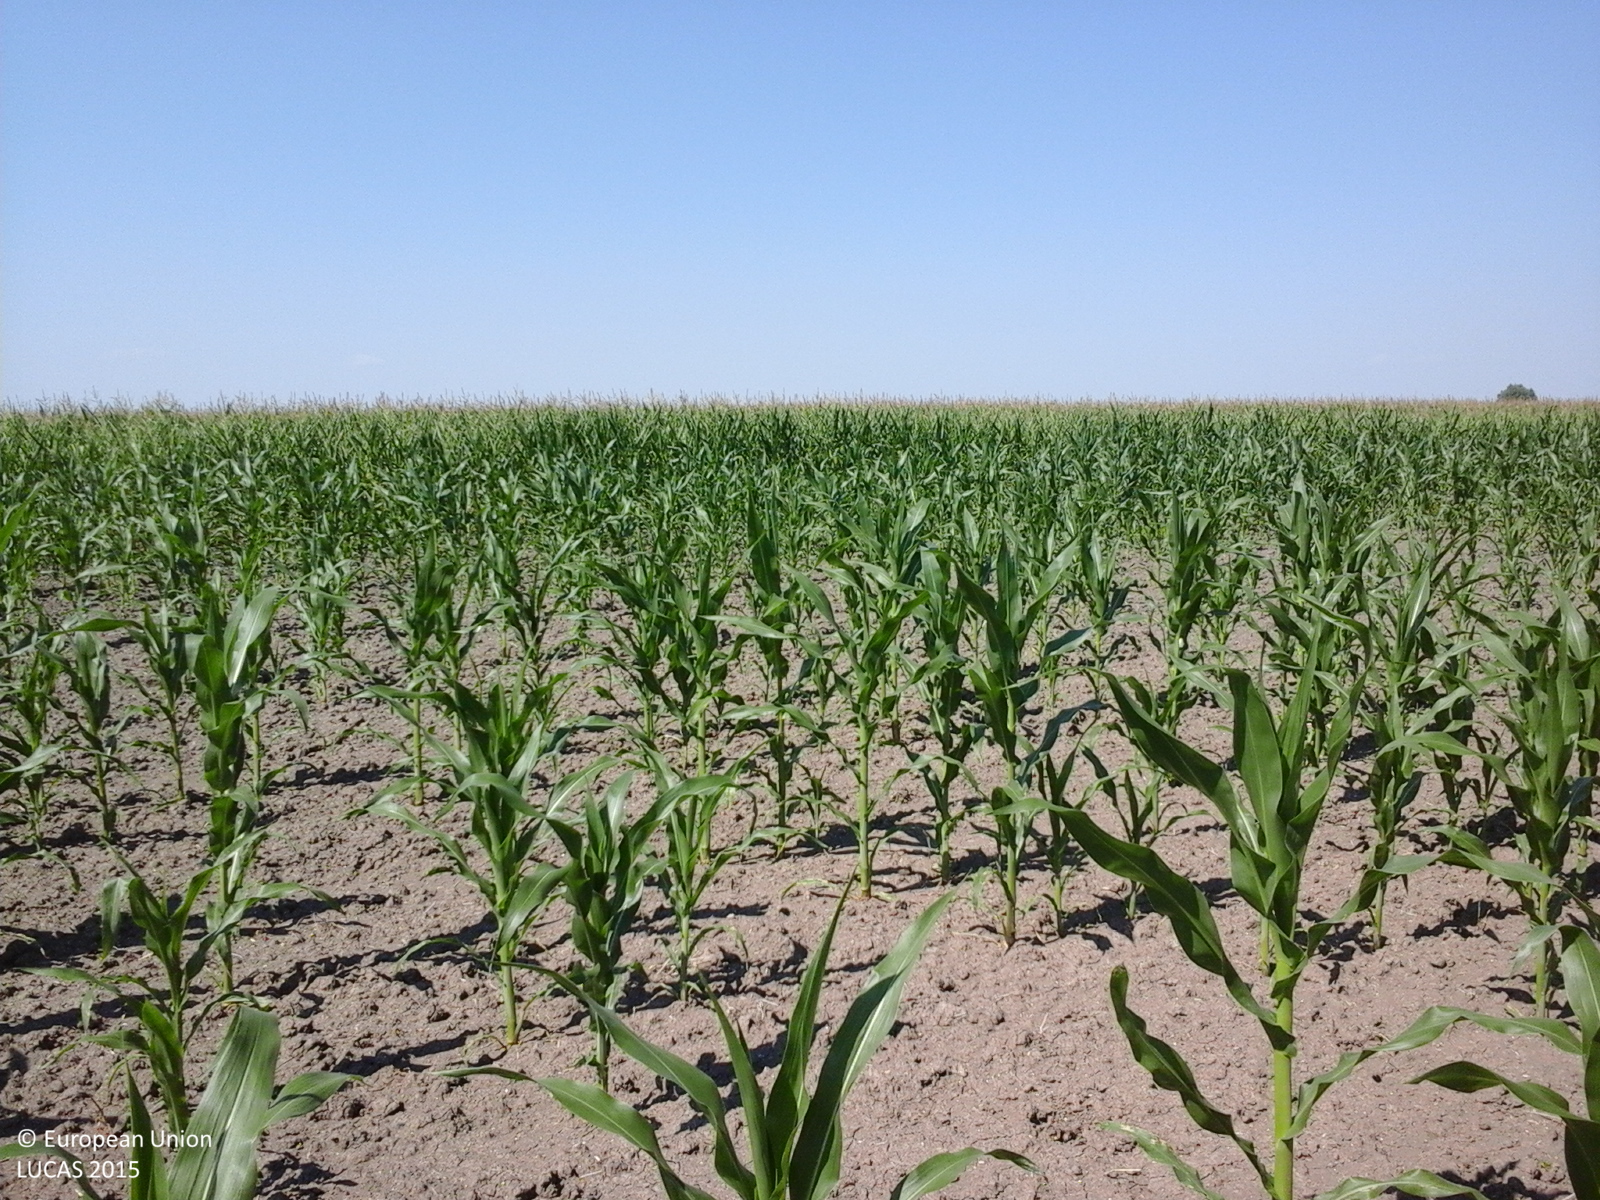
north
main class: Cropland
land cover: Maize
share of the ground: 50 - 75 %
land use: Agriculture (excluding fallow land and kitchen gardens)
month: July
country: RO
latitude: 44.2139
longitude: 27.7055
